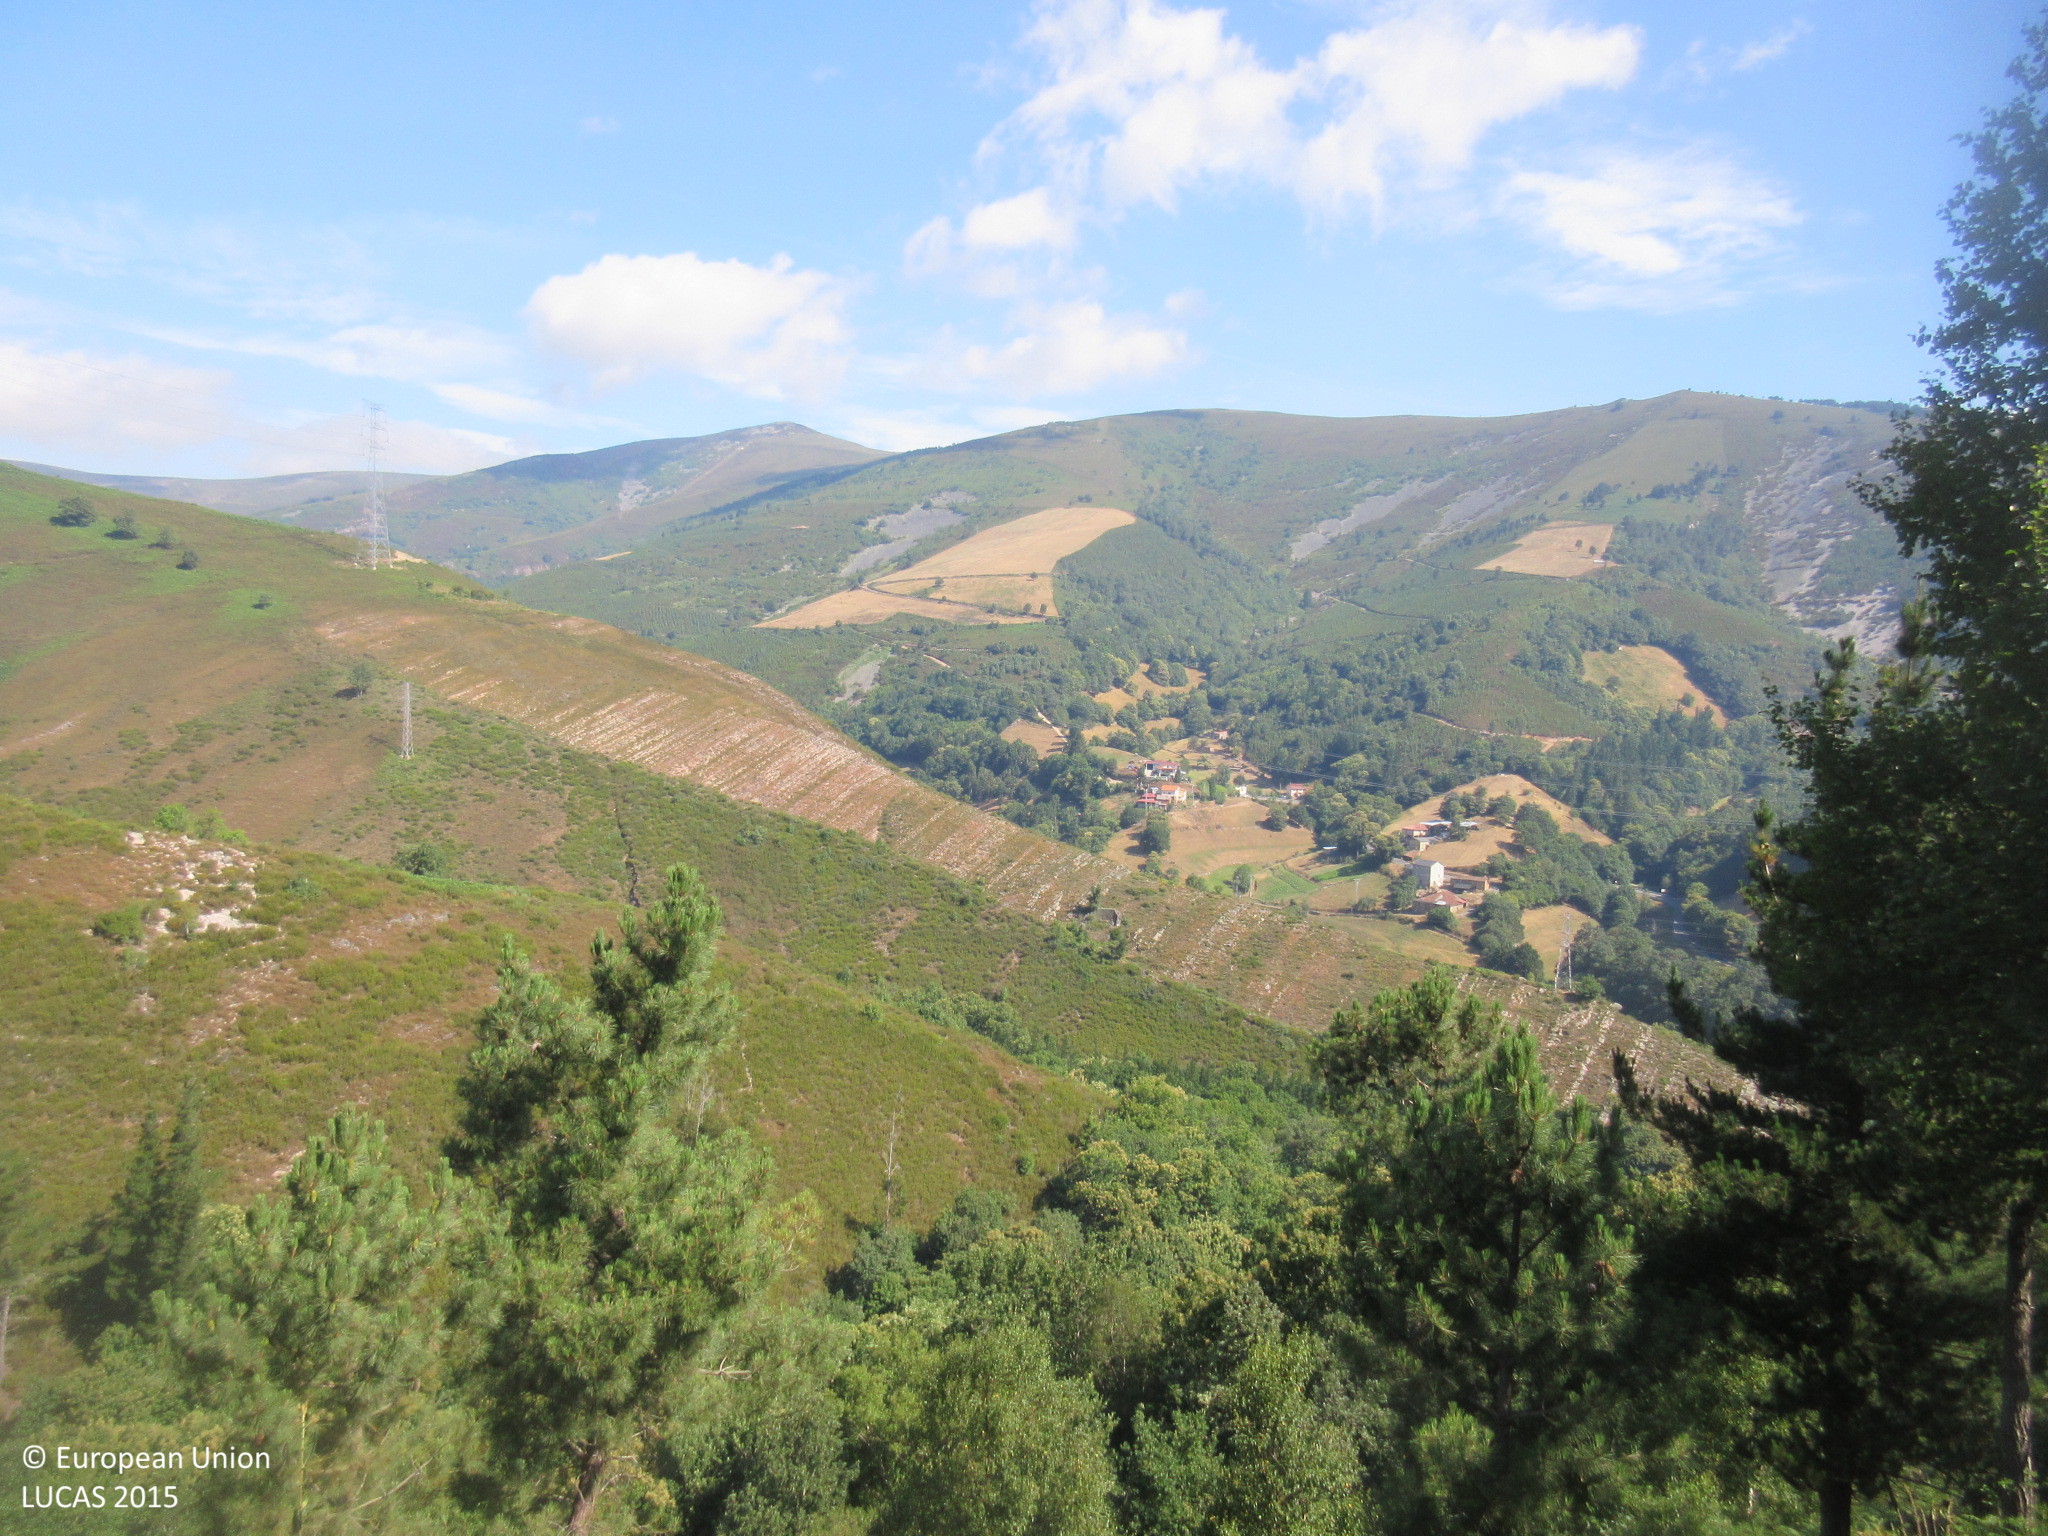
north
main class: Woodland
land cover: Broadleaved woodland
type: acidophilous oak and oak-birch forest
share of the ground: > 75 %
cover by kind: broadleaved forest trees 95 %, shrubs 5 %
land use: Forestry
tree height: > 5 m
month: July
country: ES
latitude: 43.2733
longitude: -6.6282
